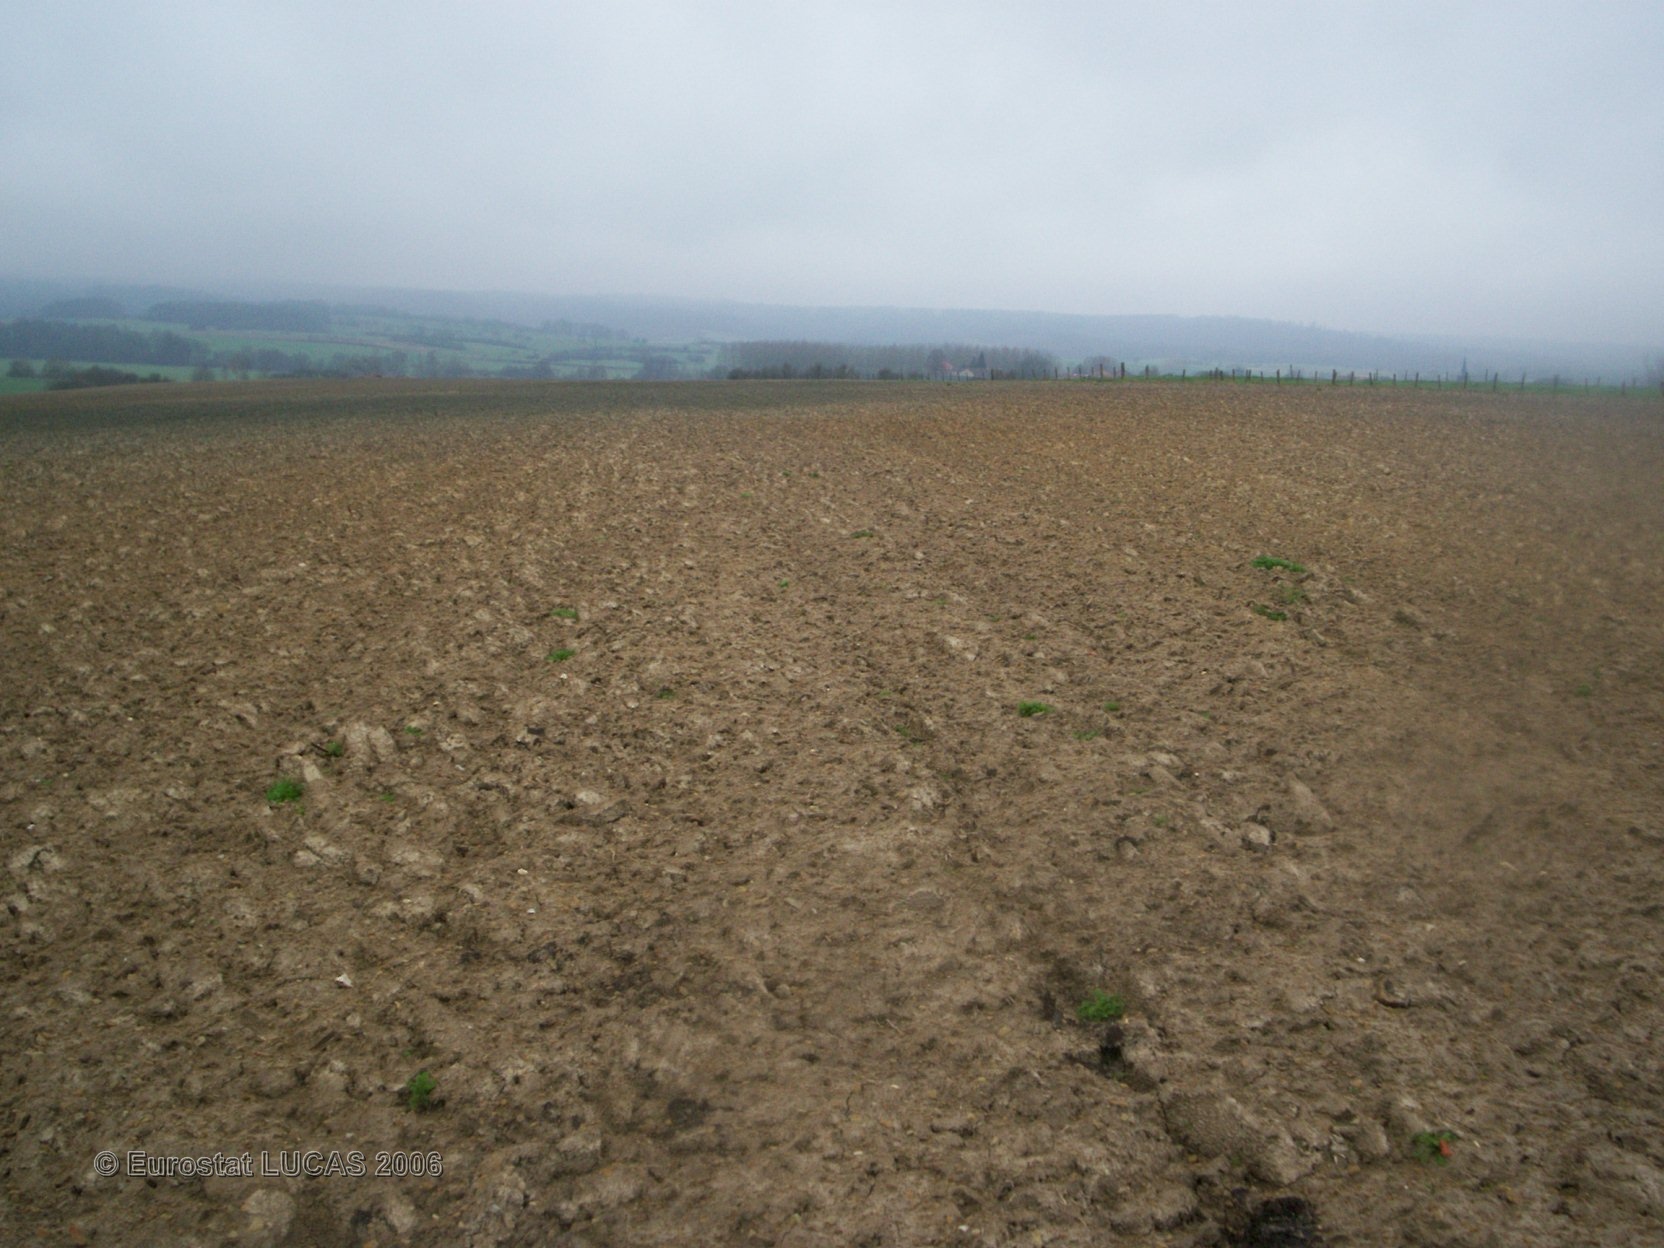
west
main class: Cropland
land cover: Maize
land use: Agriculture (excluding fallow land and kitchen gardens)
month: June
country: FR
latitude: 49.1589
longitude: 5.0751
